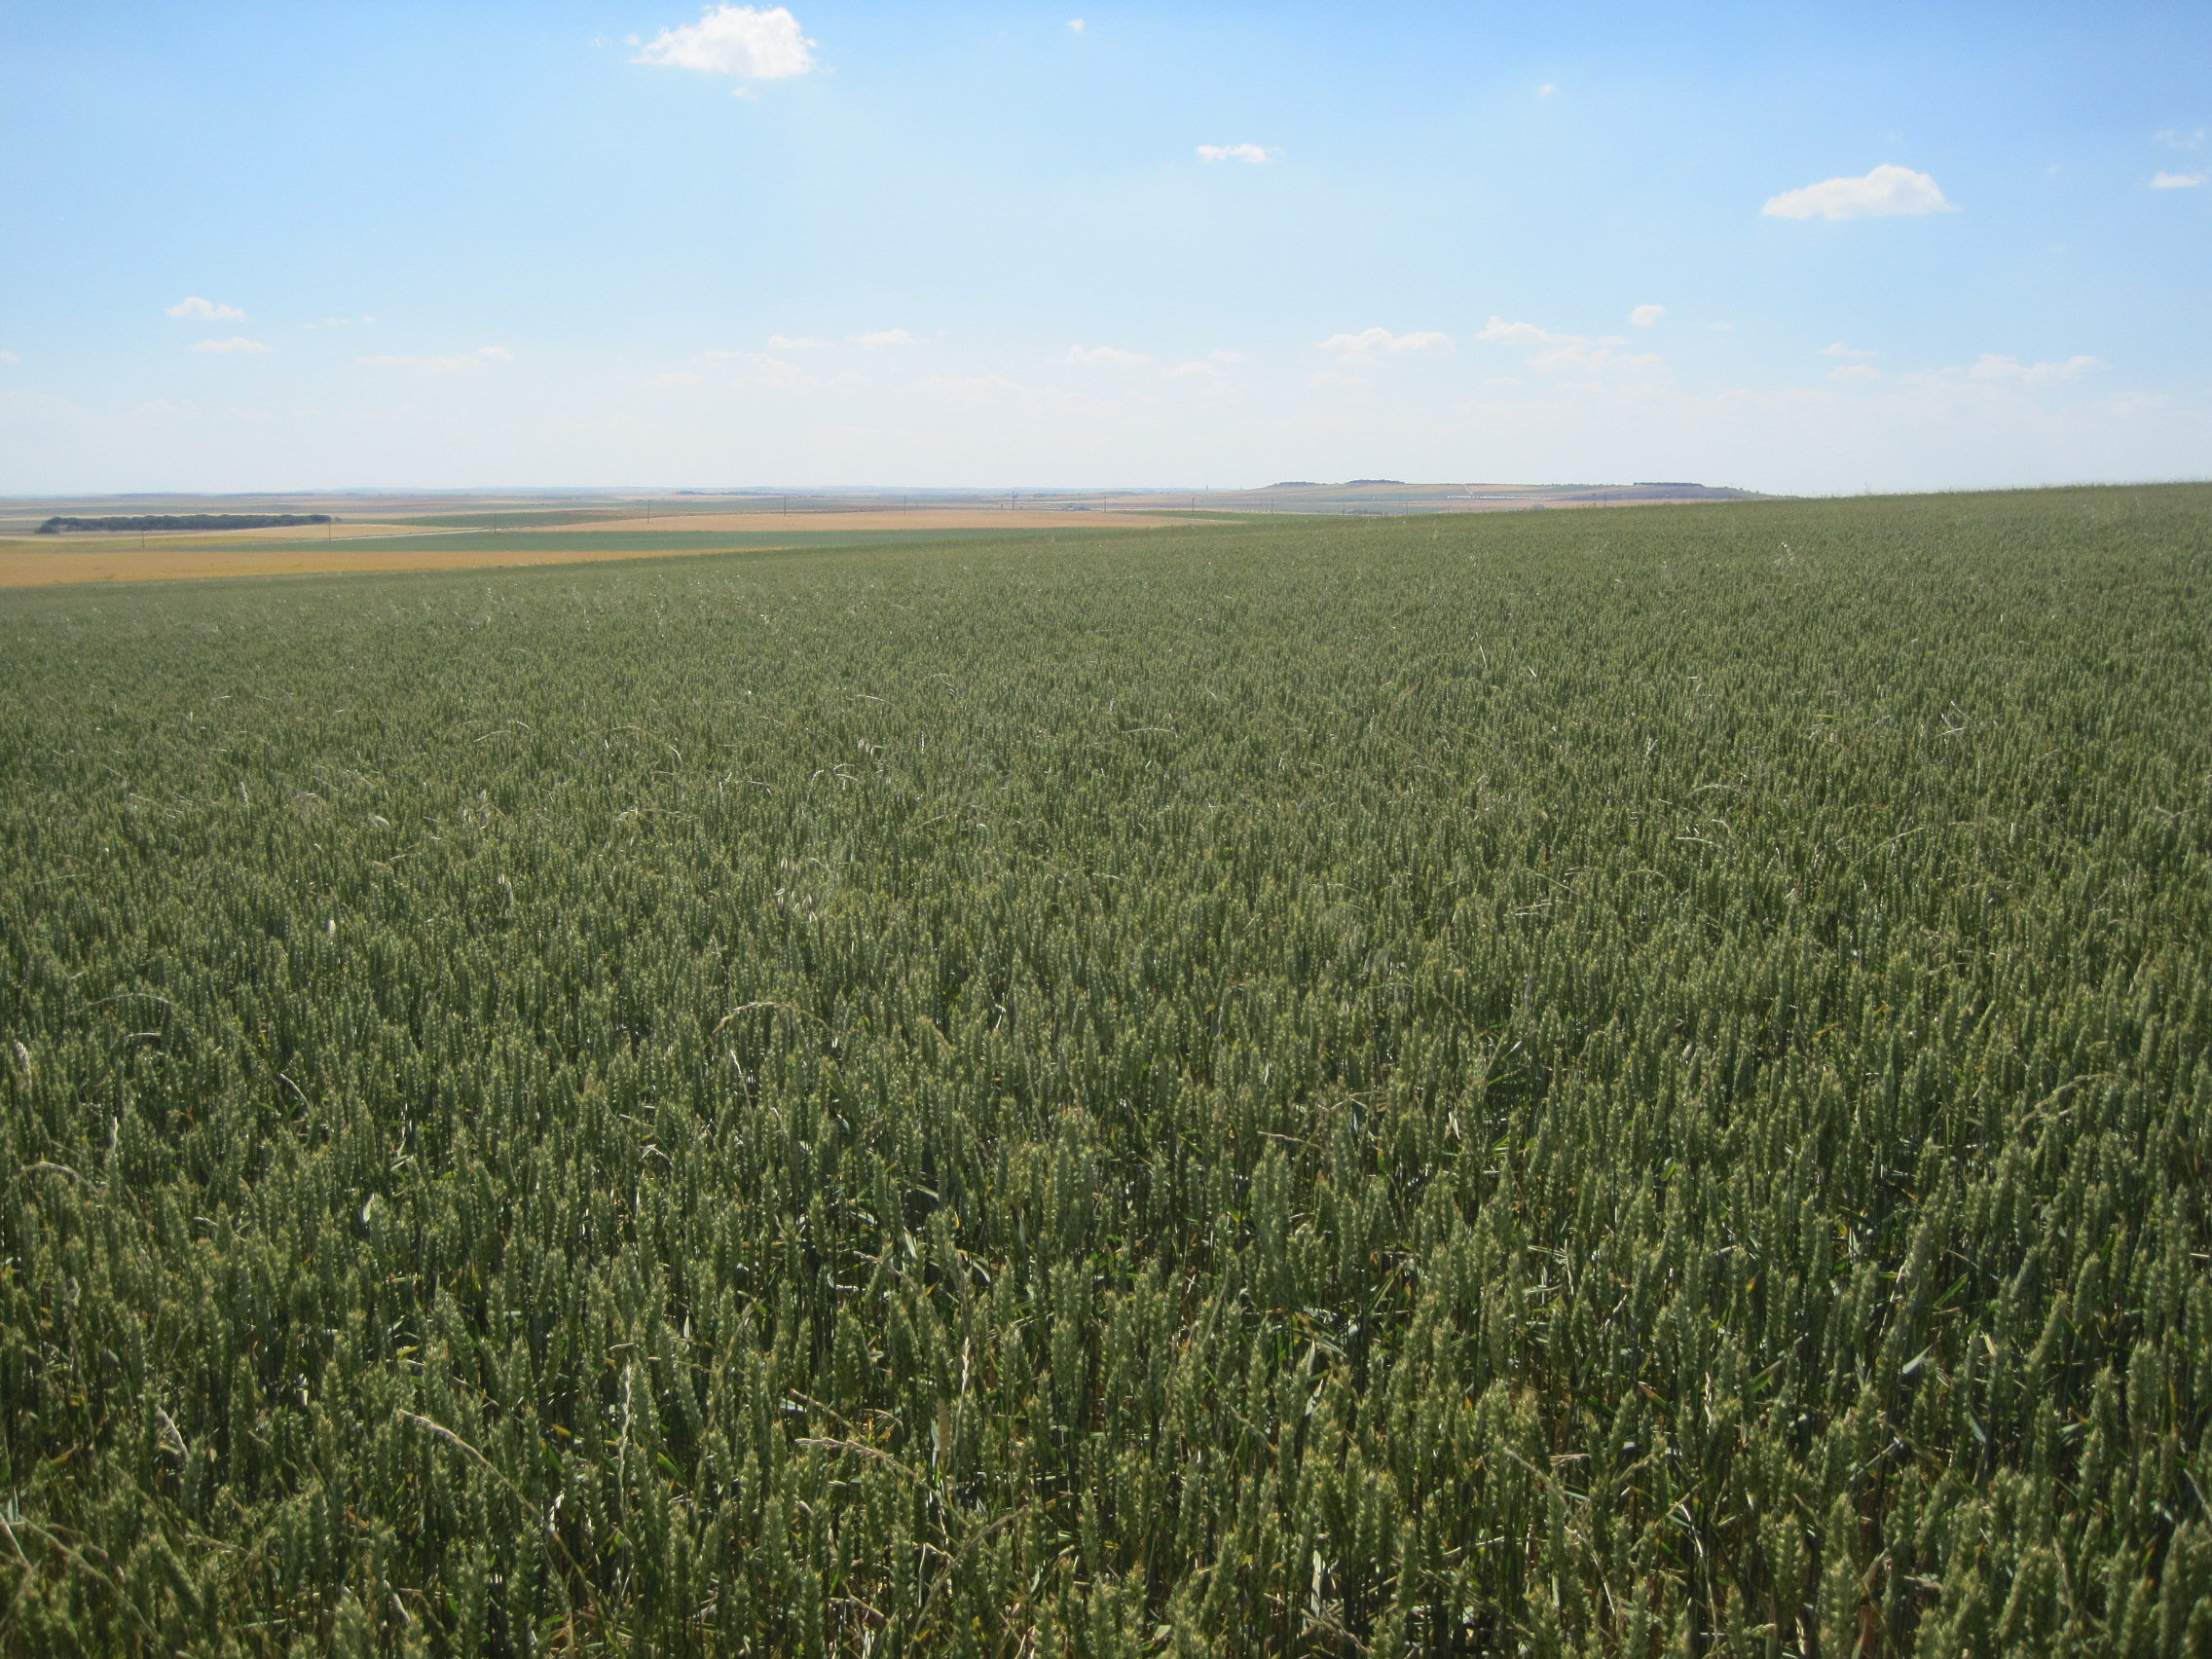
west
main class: Cropland
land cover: Common wheat
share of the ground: > 75 %
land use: Agriculture (excluding fallow land and kitchen gardens)
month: May
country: ES
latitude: 41.3219
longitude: -5.0397
